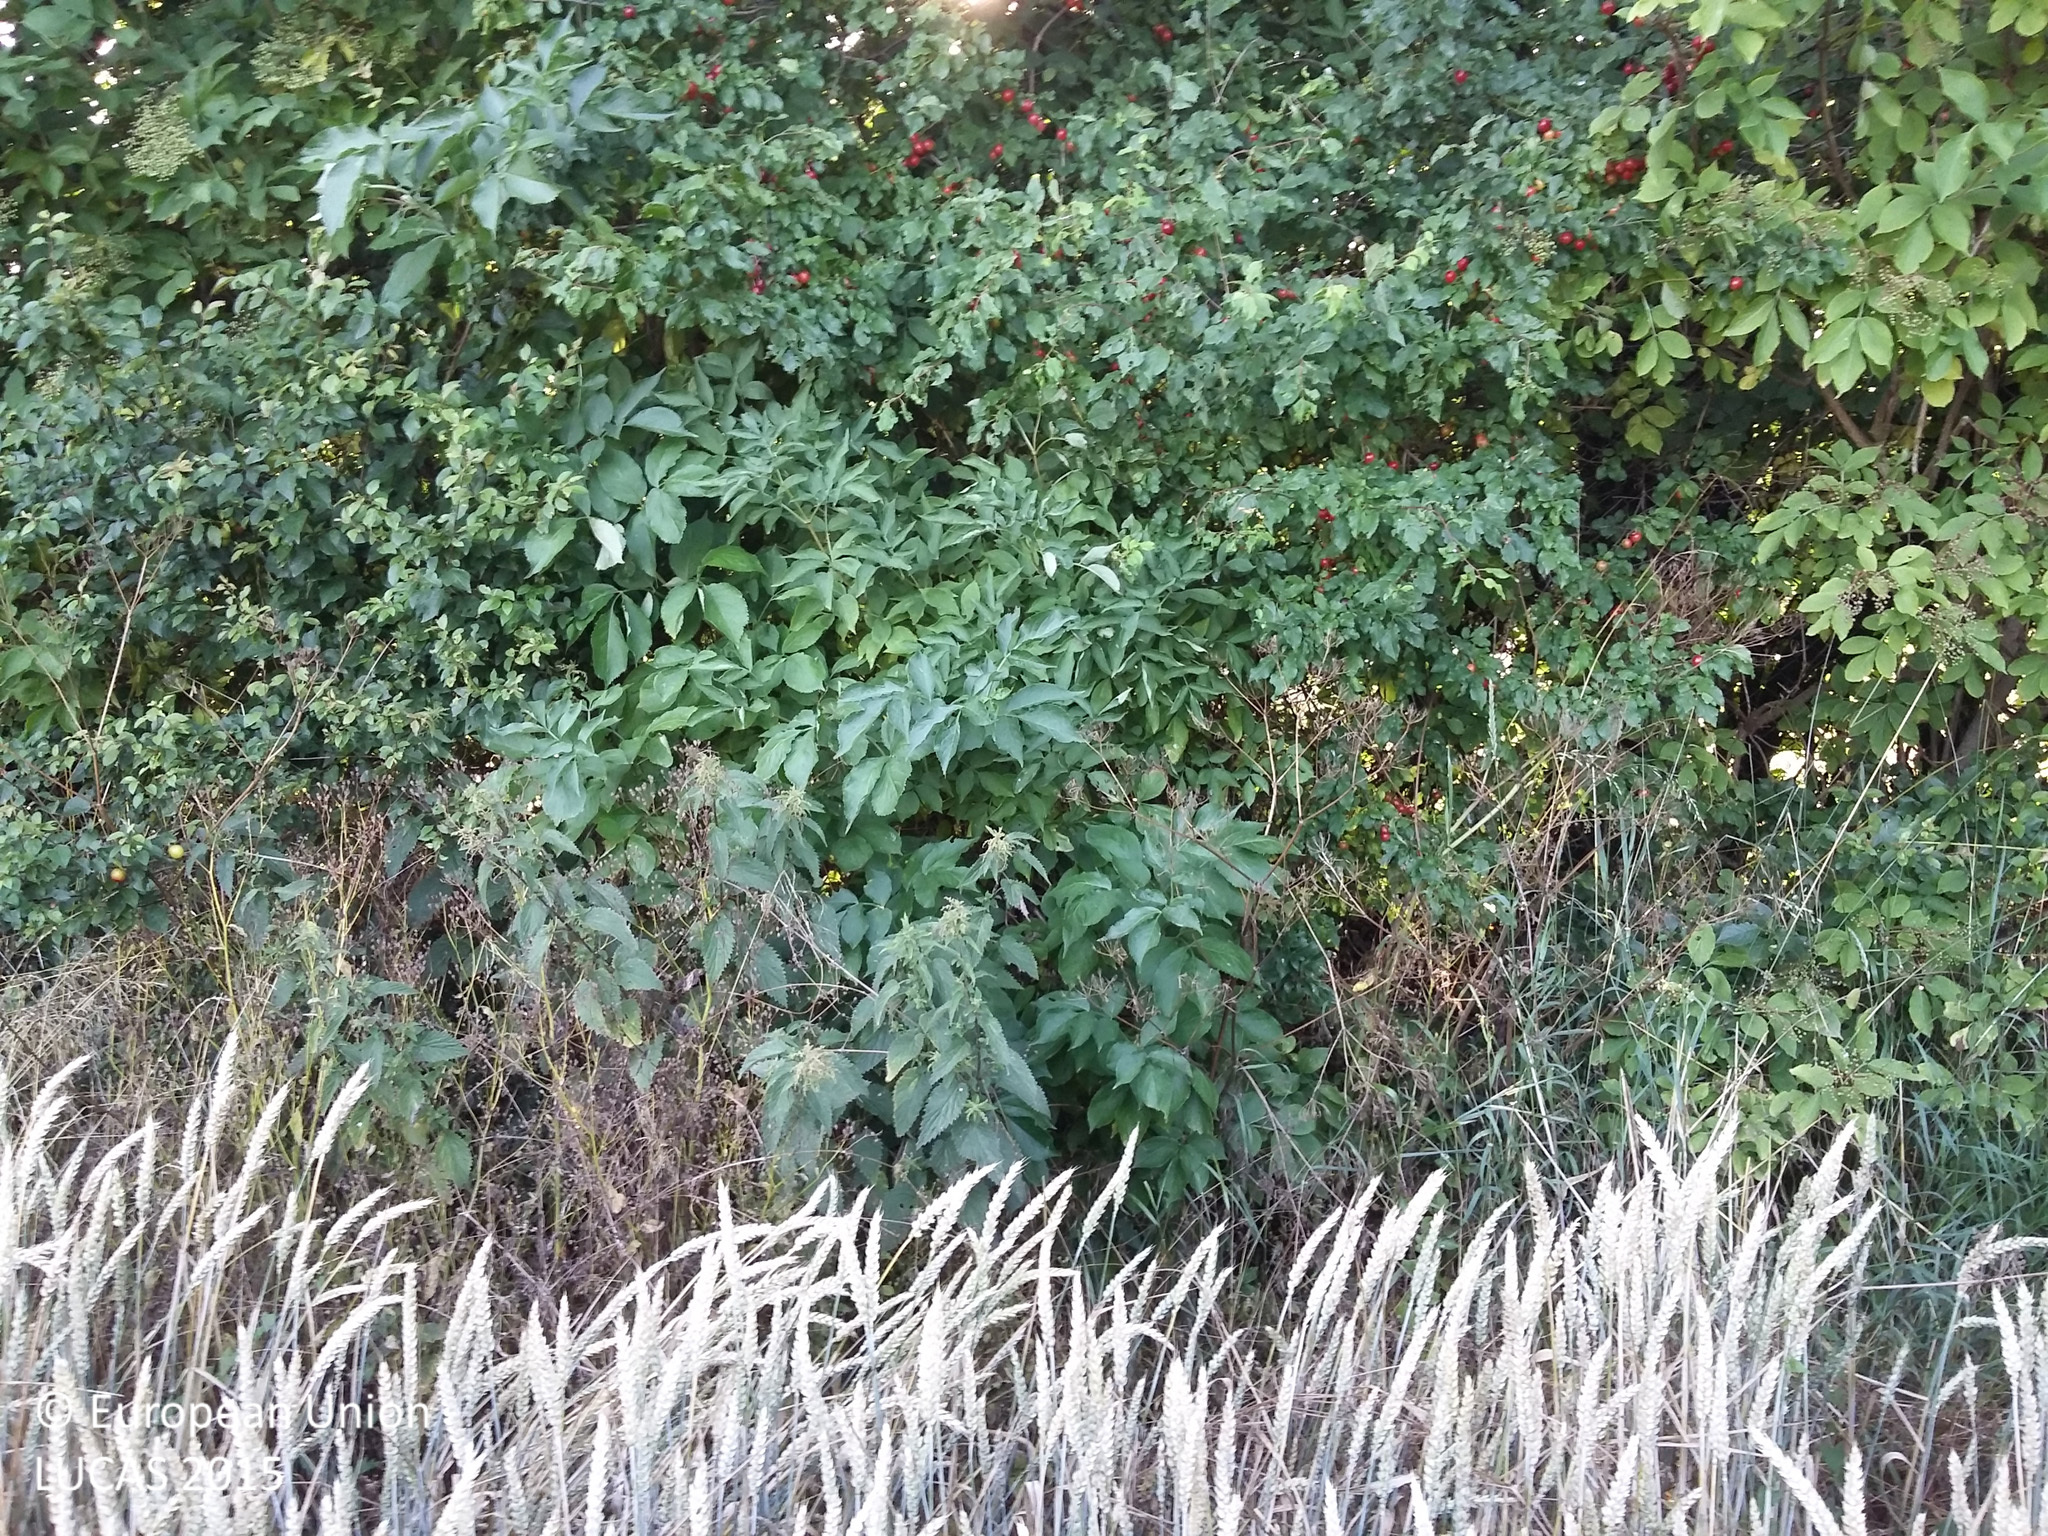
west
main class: Cropland
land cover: Common wheat
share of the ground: > 75 %
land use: Agriculture (excluding fallow land and kitchen gardens)
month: August
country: DK
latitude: 55.3576
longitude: 12.3171
